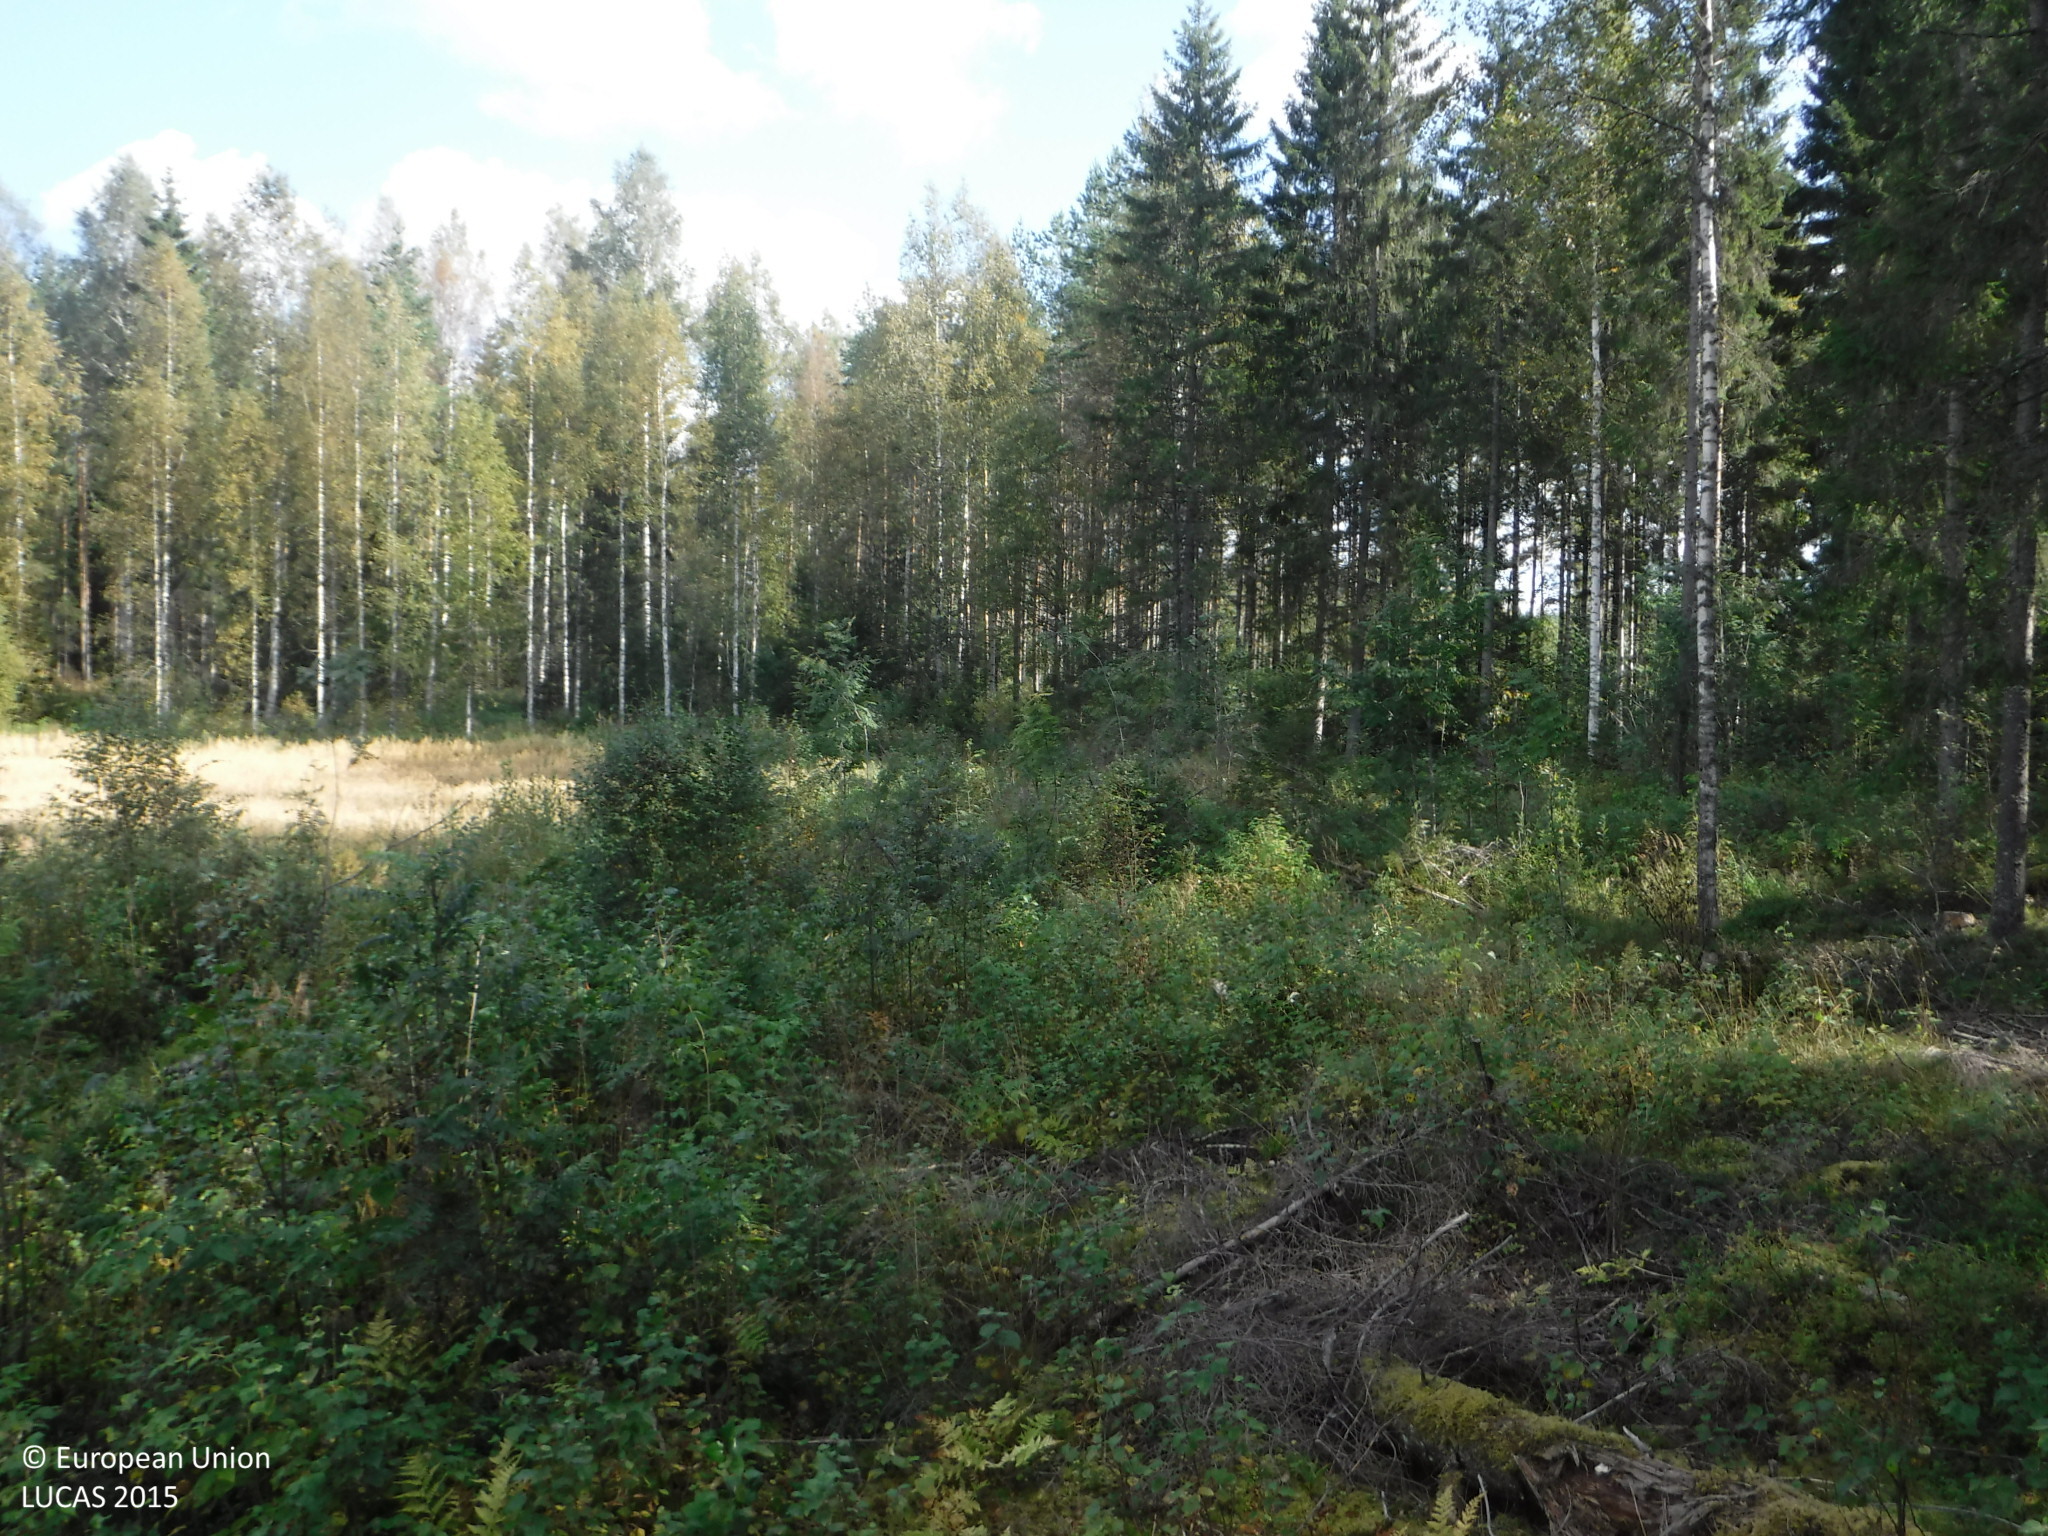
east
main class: Woodland
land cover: Spruce dominated coniferous woodland
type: boreal forest
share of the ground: 25 - 50 %
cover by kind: lichens and mosses 45 %, coniferous forest trees 40 %, shrubs 15 %
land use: Forestry
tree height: > 5 m
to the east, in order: Spruce dominated coniferous woodland; Spruce dominated mixed woodland; Ditches and canals; Spruce dominated mixed woodland; Tracks; Other coniferous woodland; Electric lines; Groves; Ditches and canals; Paved roads, cycling and walking lanes; Ditches and canals; Shruby margins; Electric lines; Spruce dominated mixed woodland; Shrubland with sparse tree cover; Spruce dominated mixed woodland
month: September
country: FI
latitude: 61.7332
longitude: 22.3825
